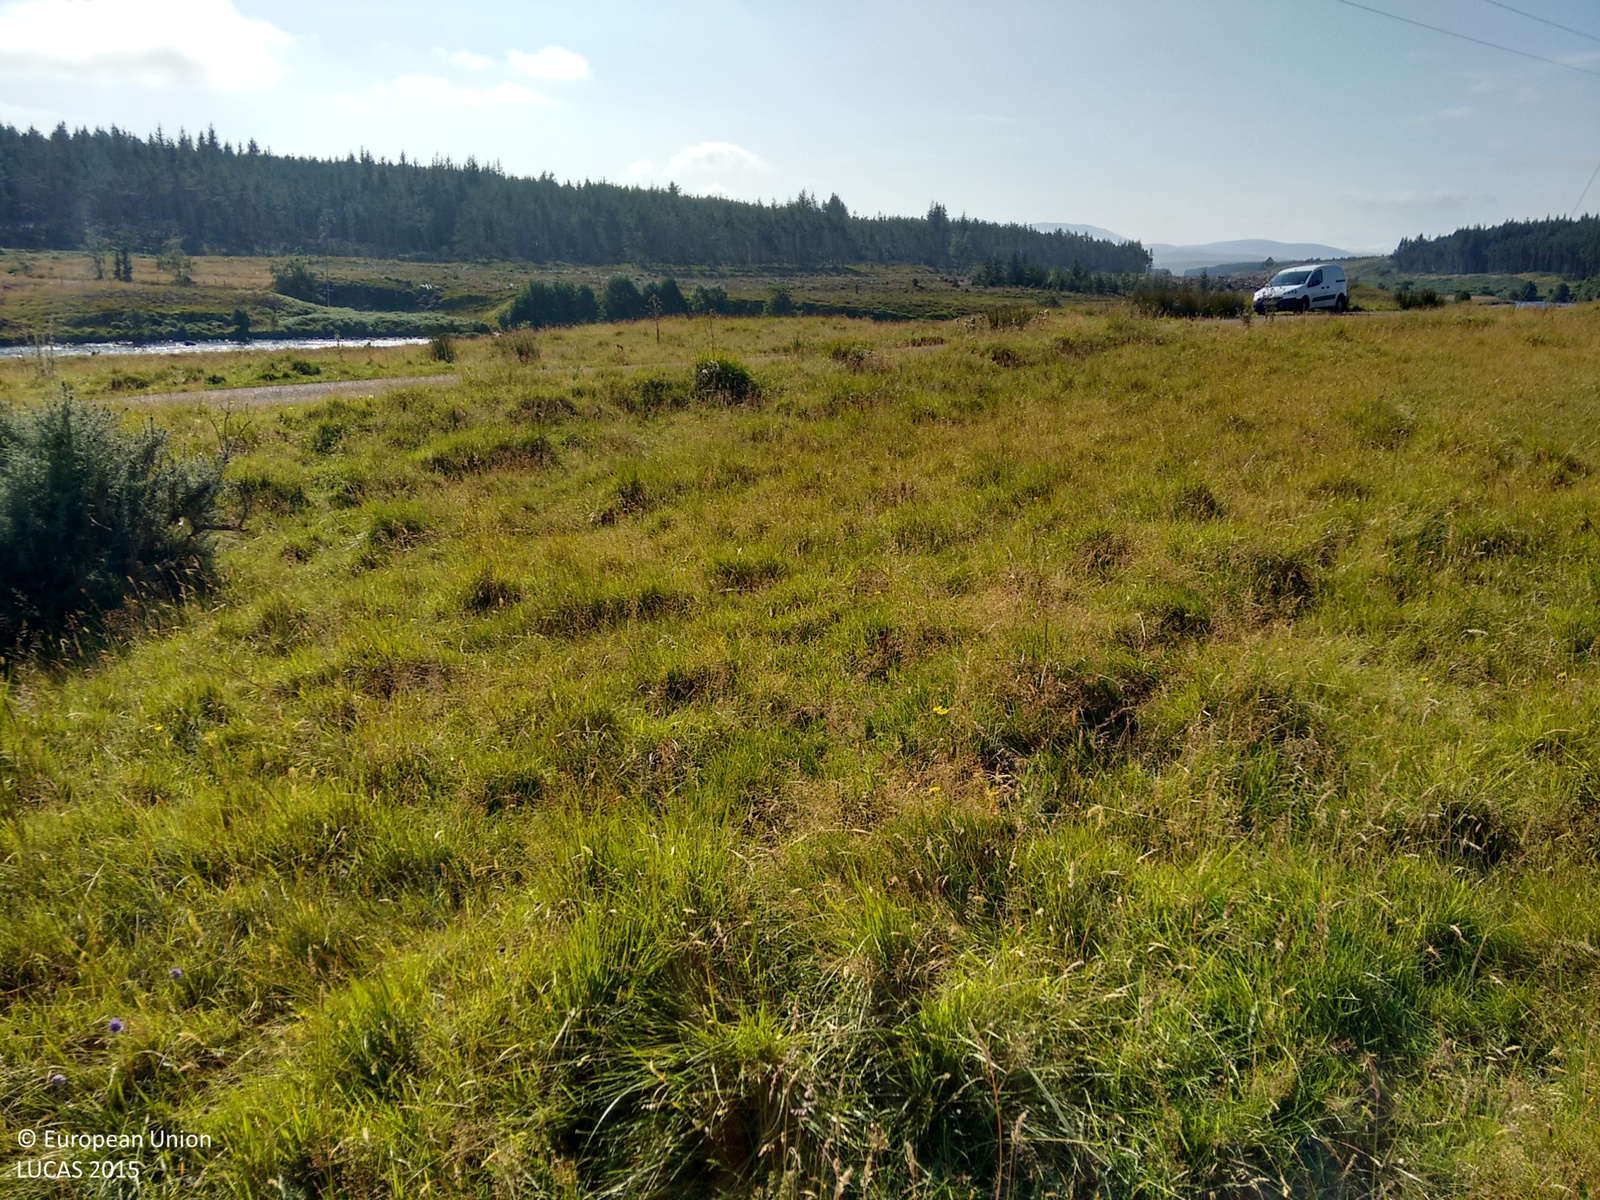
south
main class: Woodland
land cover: Pine dominated coniferous woodland
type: hemiboreal forest and nemoral coniferous forest and mixed broadleaved-coniferous forest
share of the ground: > 75 %
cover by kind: coniferous forest trees 100 %
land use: Forestry
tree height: > 5 m
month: September
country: GB
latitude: 58.3525
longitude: -4.2461
